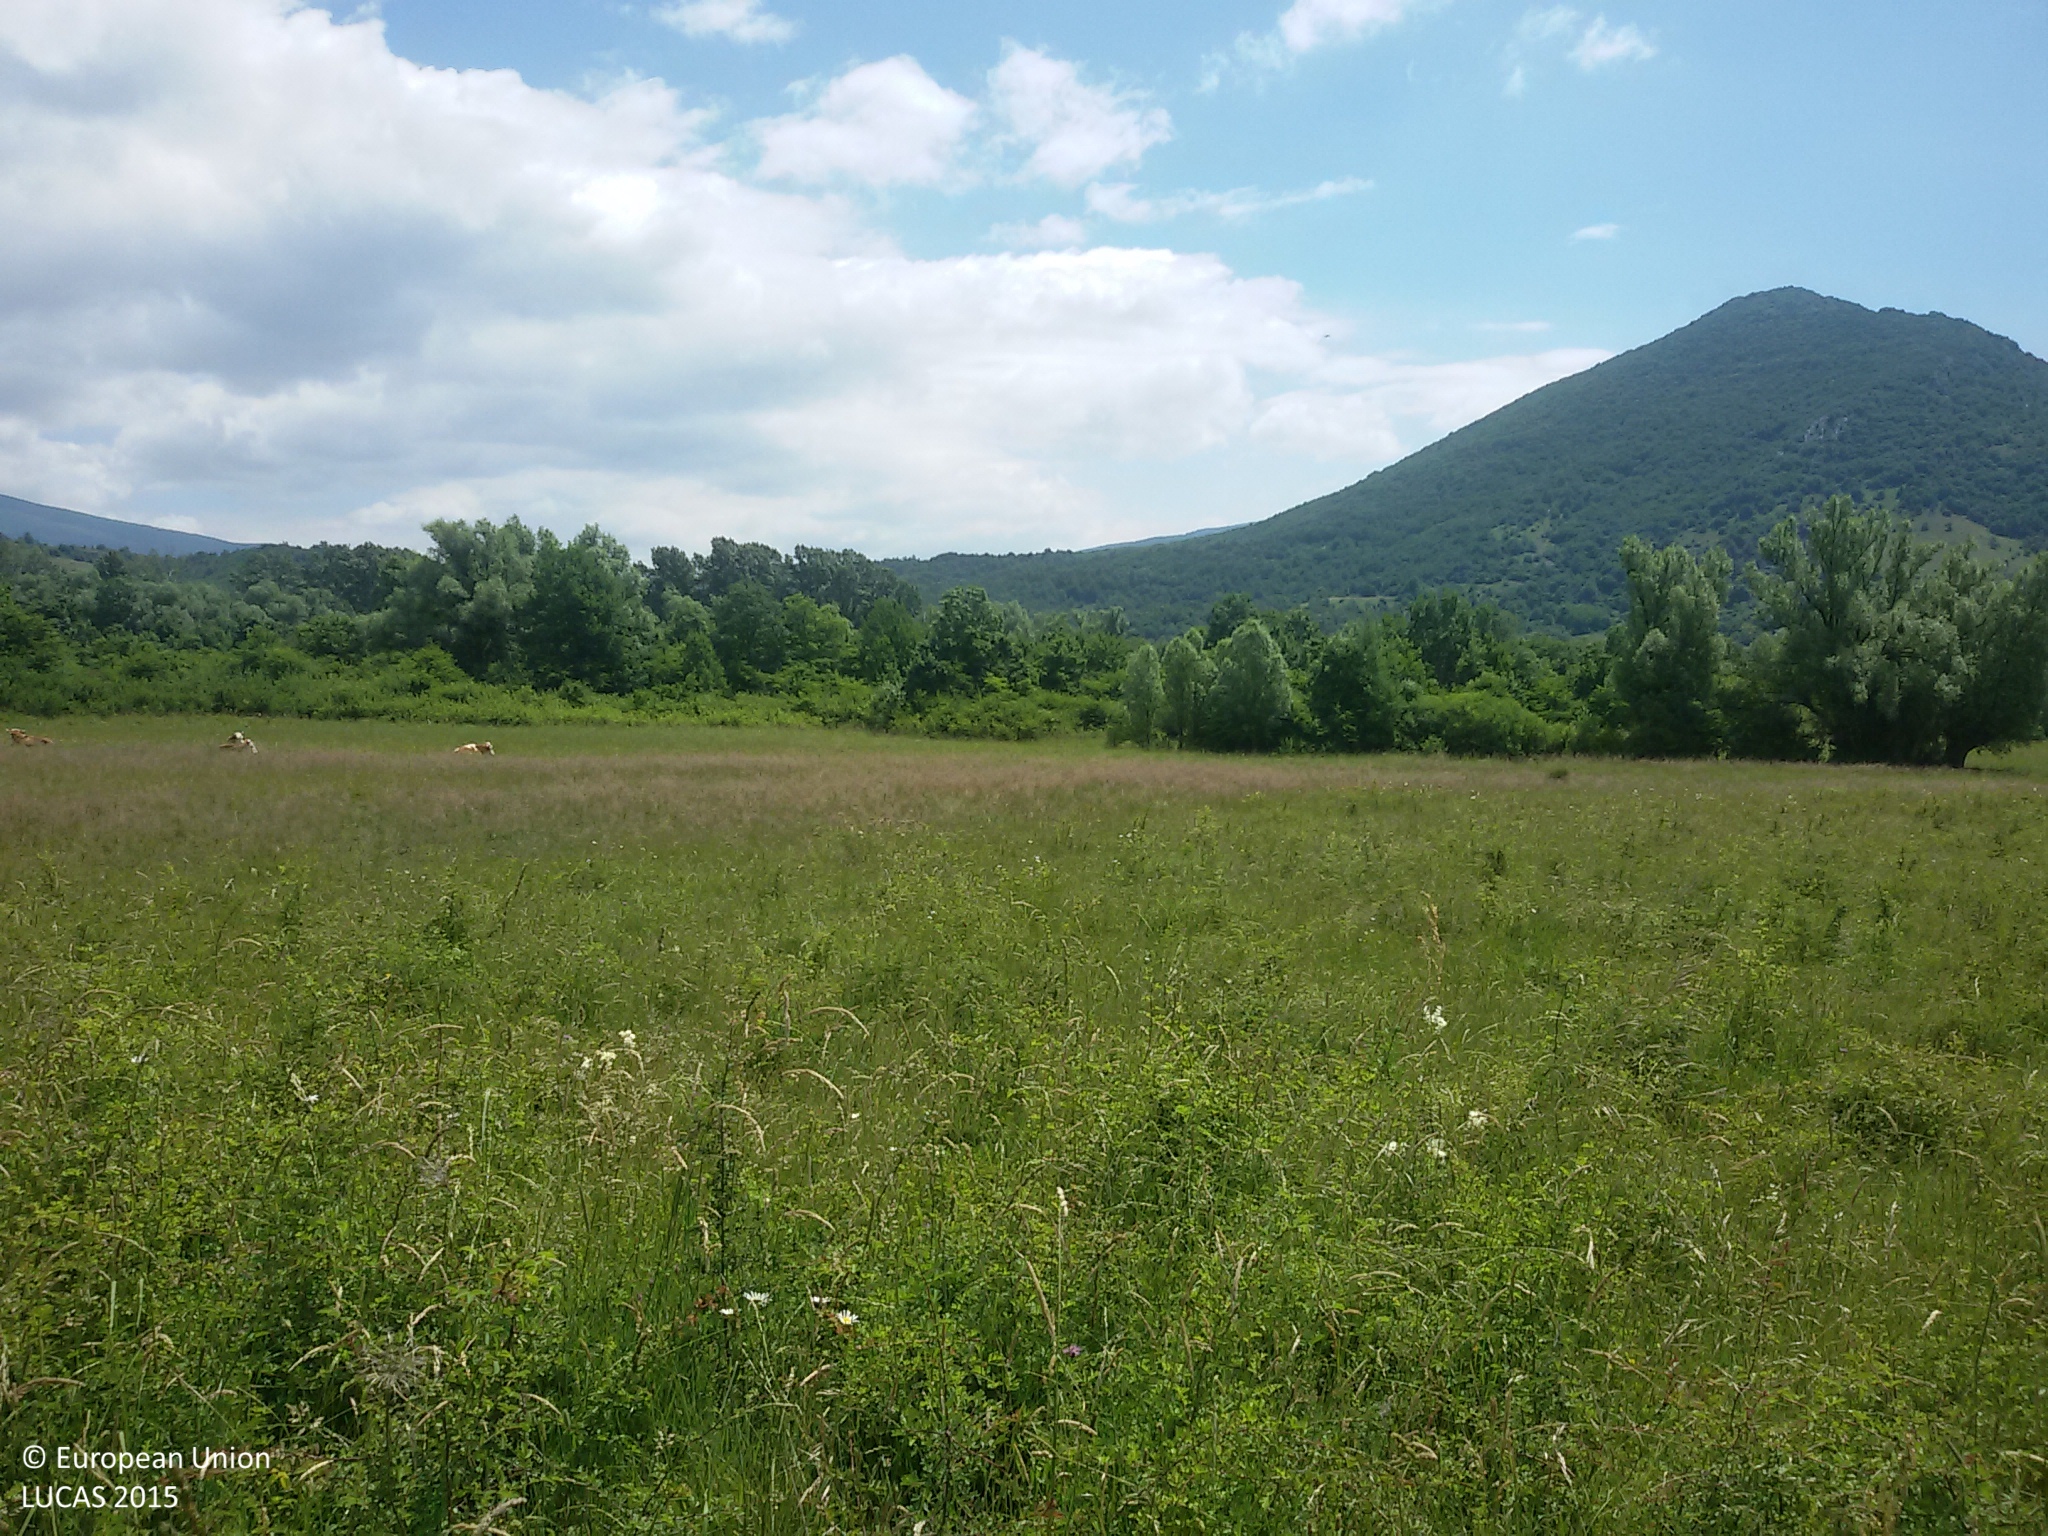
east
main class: Grassland
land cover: Grassland without tree/shrub cover
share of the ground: > 75 %
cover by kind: herbaceous plants 90 %, shrubs 5 %, unconsolidated bare surface 5 %
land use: Agriculture (excluding fallow land and kitchen gardens)
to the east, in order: Grassland without tree/shrub cover; Shrubland with sparse tree cover; Broadleaved woodland; Shrubland with sparse tree cover; Grassland without tree/shrub cover
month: June
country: HR
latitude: 44.5155
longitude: 15.7680
